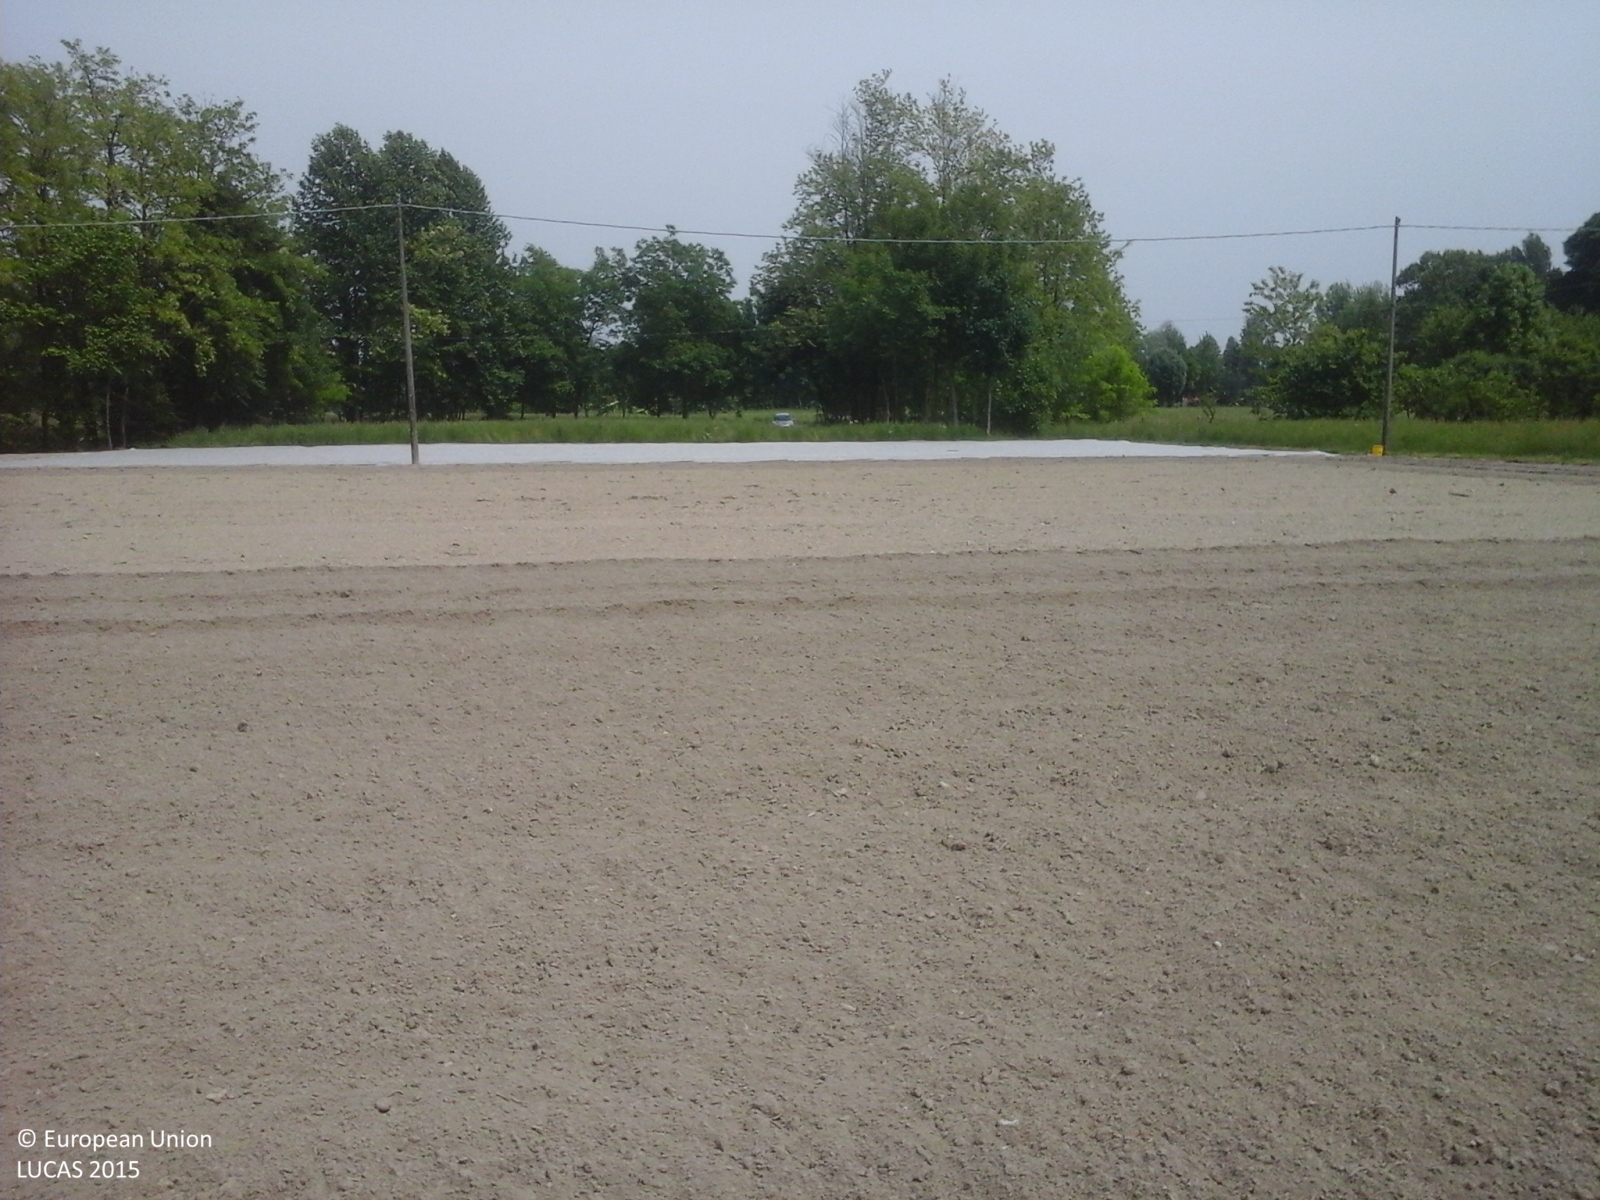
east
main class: Cropland
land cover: Other fresh vegetables
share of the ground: < 10 %
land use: Agriculture (excluding fallow land and kitchen gardens)
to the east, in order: Other fresh vegetables; Electric lines; Other fresh vegetables; Grassland without tree/shrub cover; Broadleaved woodland; Grassland without tree/shrub cover; Paved roads, cycling and walking lanes; Grassland without tree/shrub cover; Other fresh vegetables
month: May
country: IT
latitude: 45.6160
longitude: 11.7541
